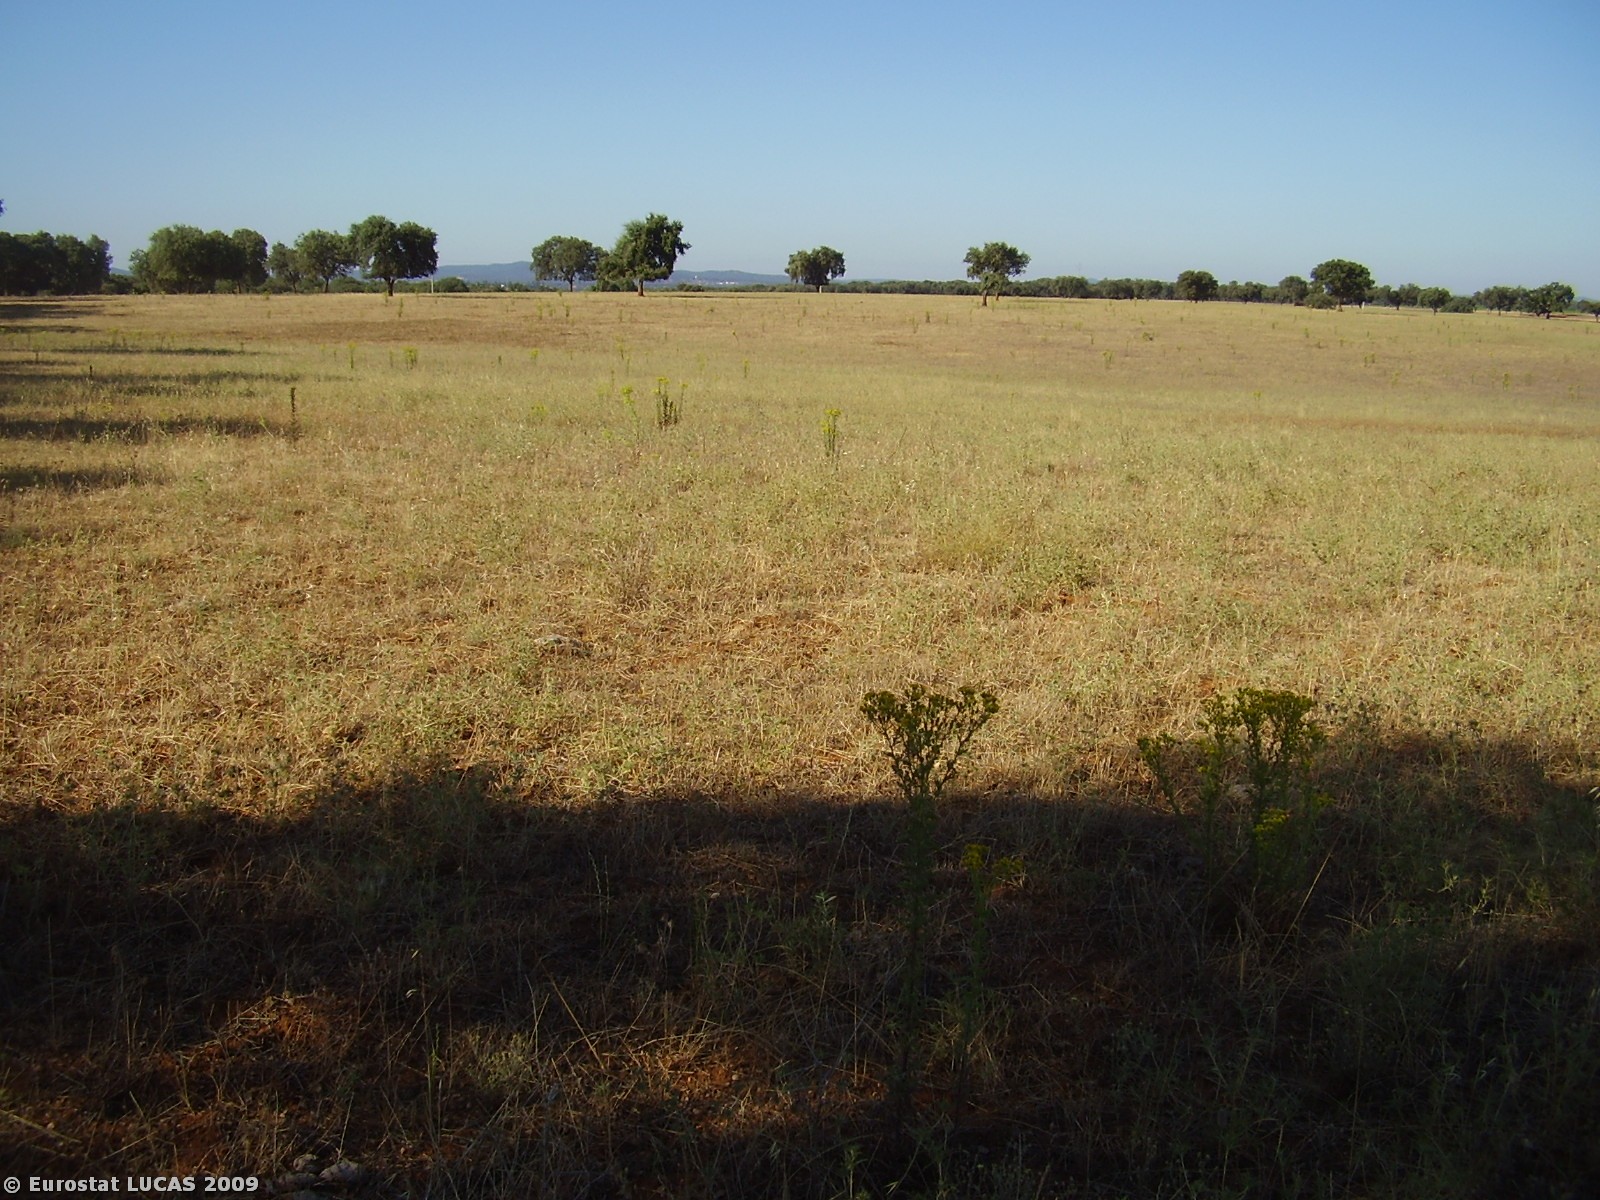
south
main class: Grassland
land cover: Grassland with sparse tree/shrub cover
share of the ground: > 75 %
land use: Fallow land
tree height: > 5 m
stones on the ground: 25 - 50 %
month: July
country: PT
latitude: 38.8772
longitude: -7.7347
